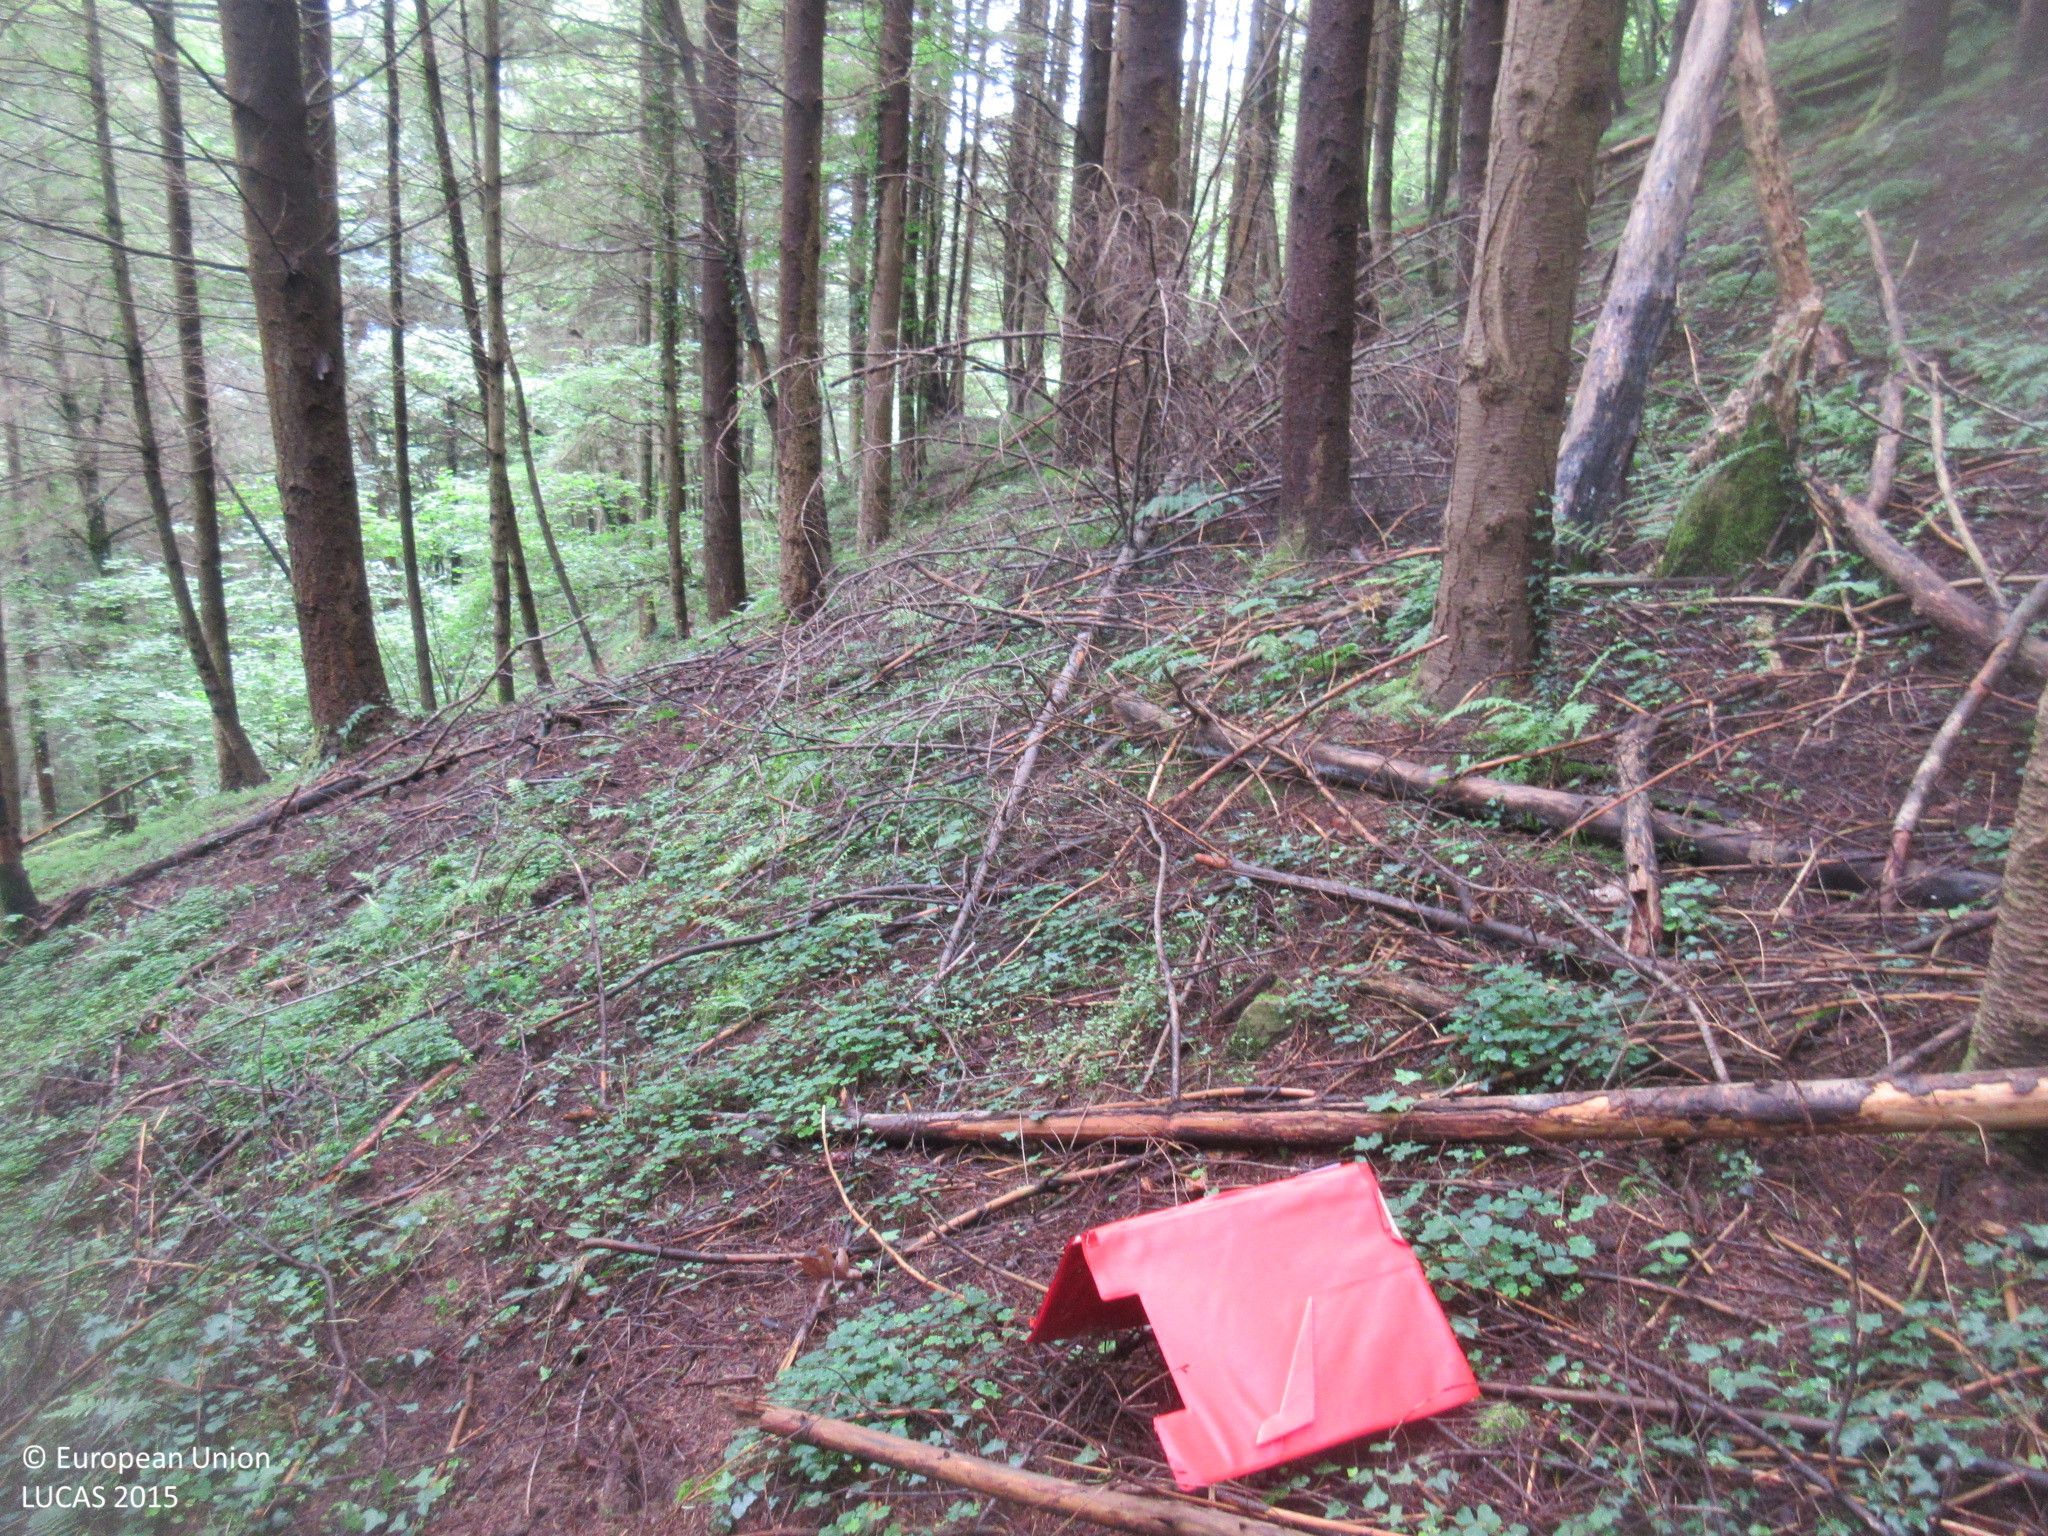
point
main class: Woodland
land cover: Spruce dominated coniferous woodland
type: hemiboreal forest and nemoral coniferous forest and mixed broadleaved-coniferous forest
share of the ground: > 75 %
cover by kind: coniferous forest trees 100 %
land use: Forestry
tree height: > 5 m
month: July
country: ES
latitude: 43.2931
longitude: -5.2215
